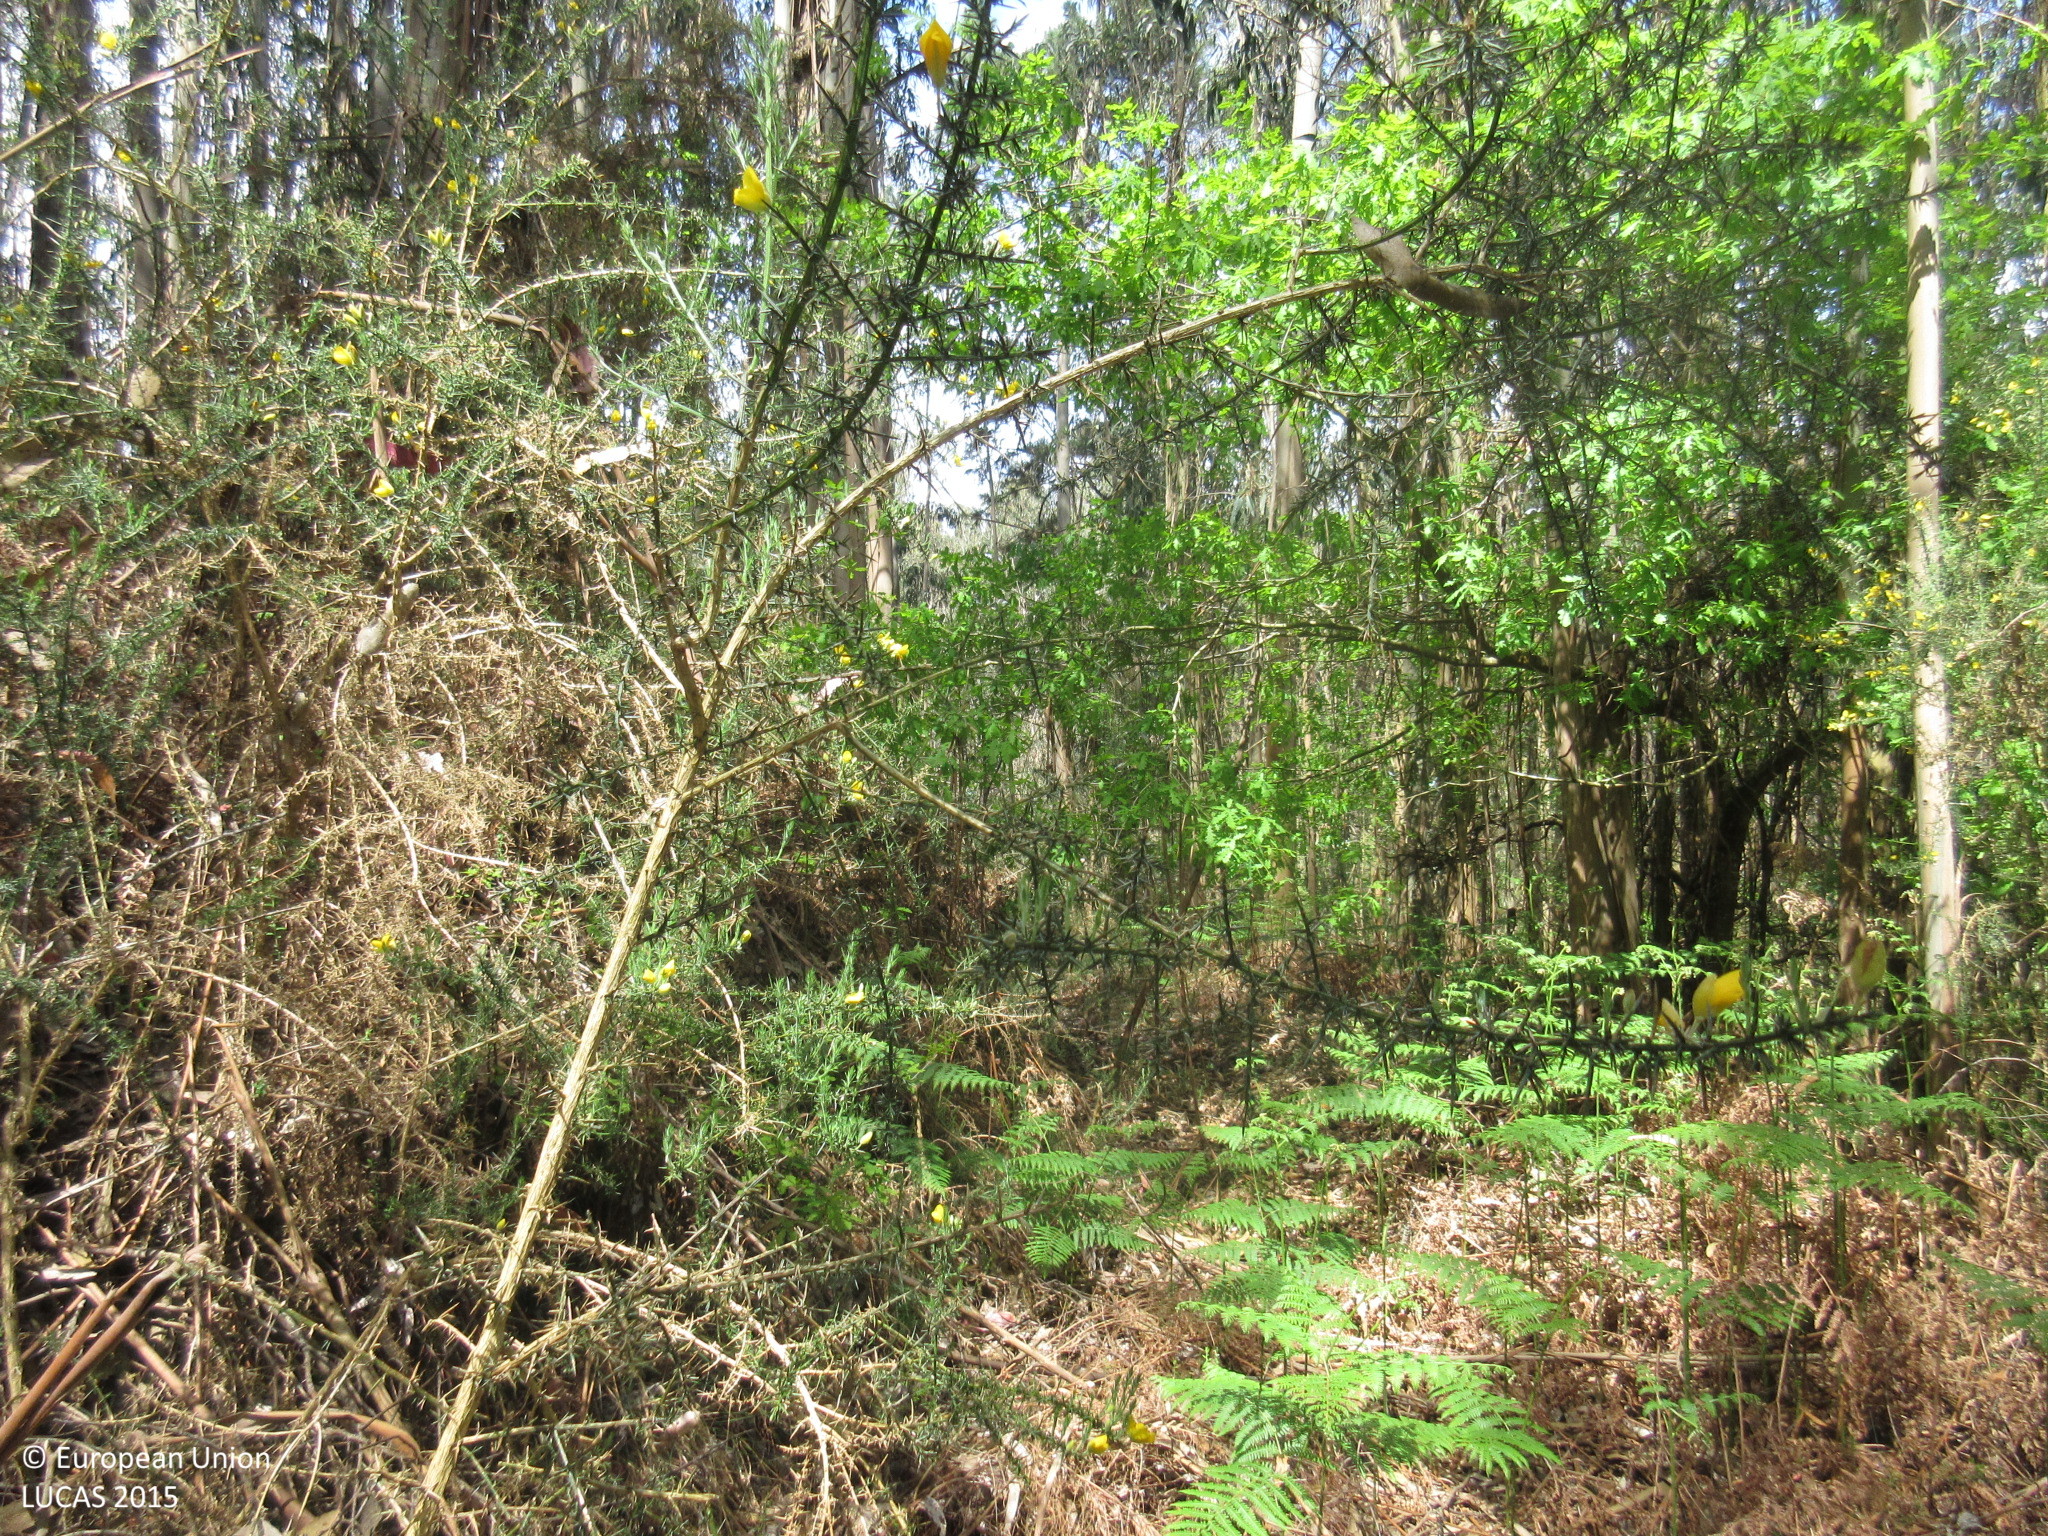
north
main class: Woodland
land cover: Broadleaved woodland
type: exotic forest
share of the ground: > 75 %
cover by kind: broadleaved forest trees 95 %, shrubs 5 %
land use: Forestry
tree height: > 5 m
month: April
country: ES
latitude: 43.5109
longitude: -7.0785
